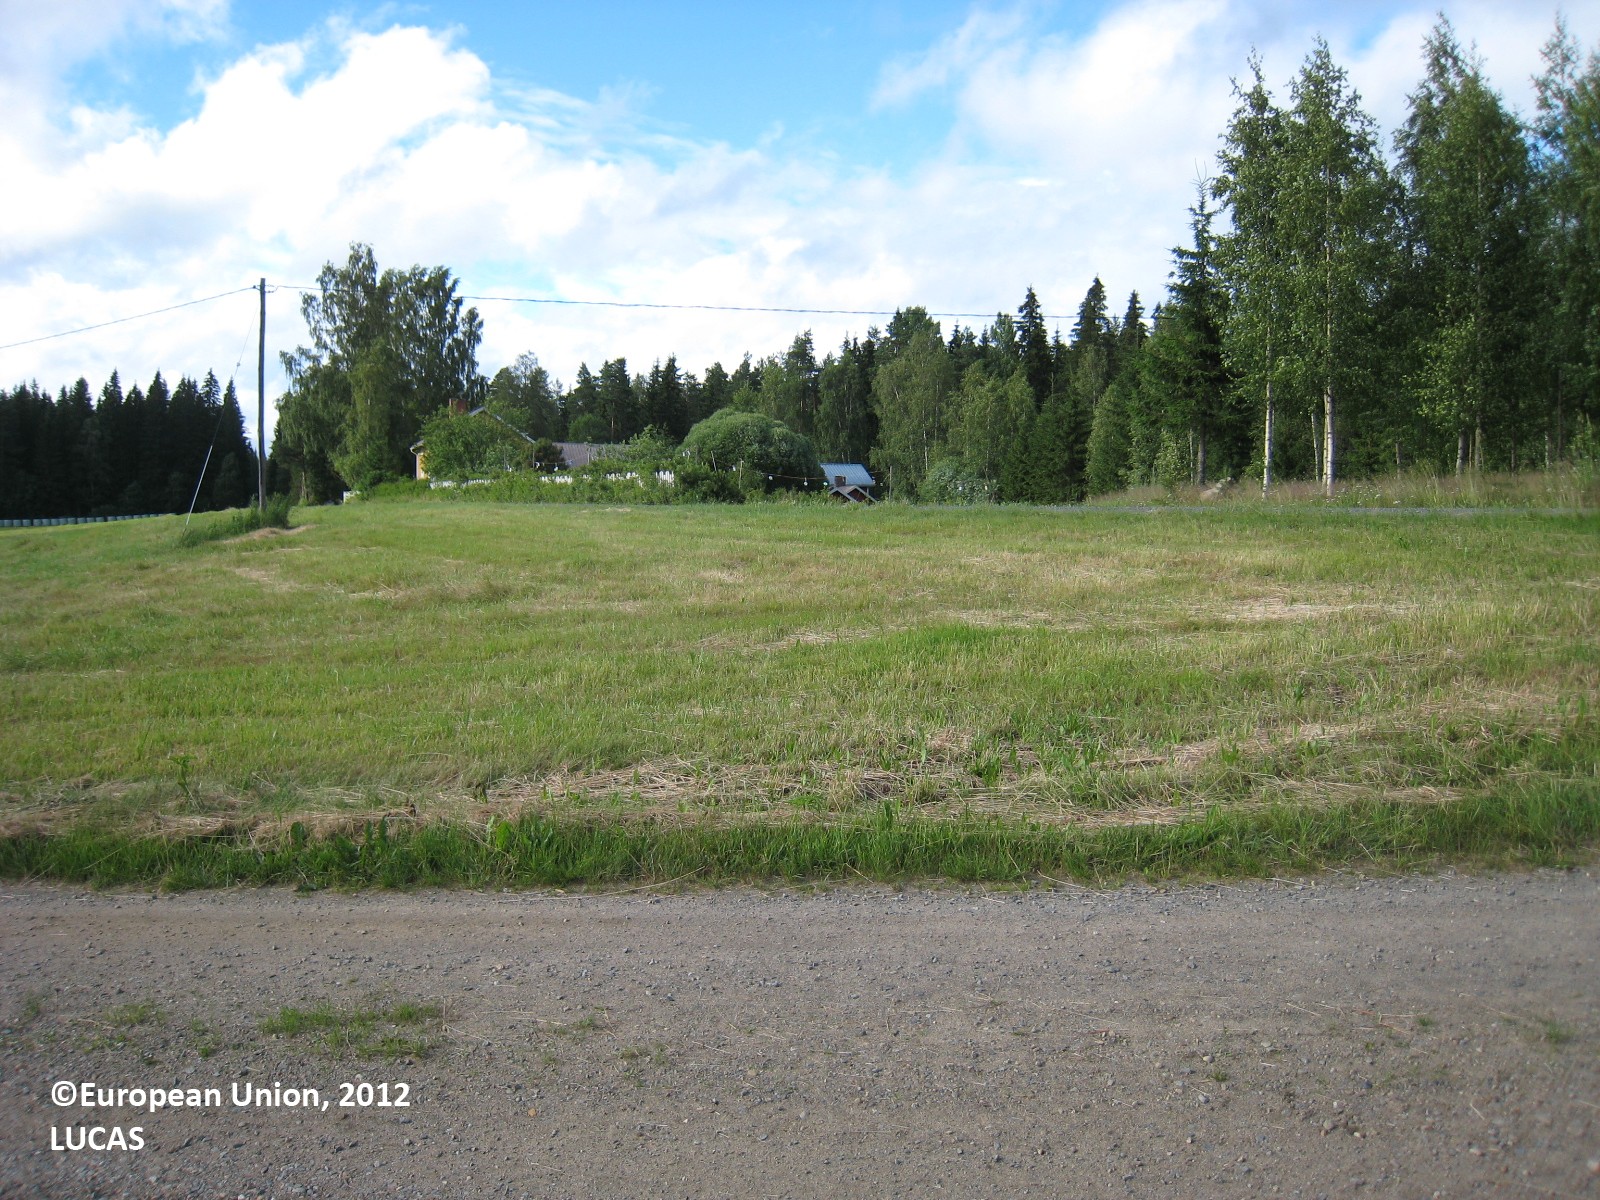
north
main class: Cropland
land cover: Temporary grasslands
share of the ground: > 75 %
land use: Agriculture (excluding fallow land and kitchen gardens)
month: July
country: FI
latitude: 61.8676
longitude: 27.3752
